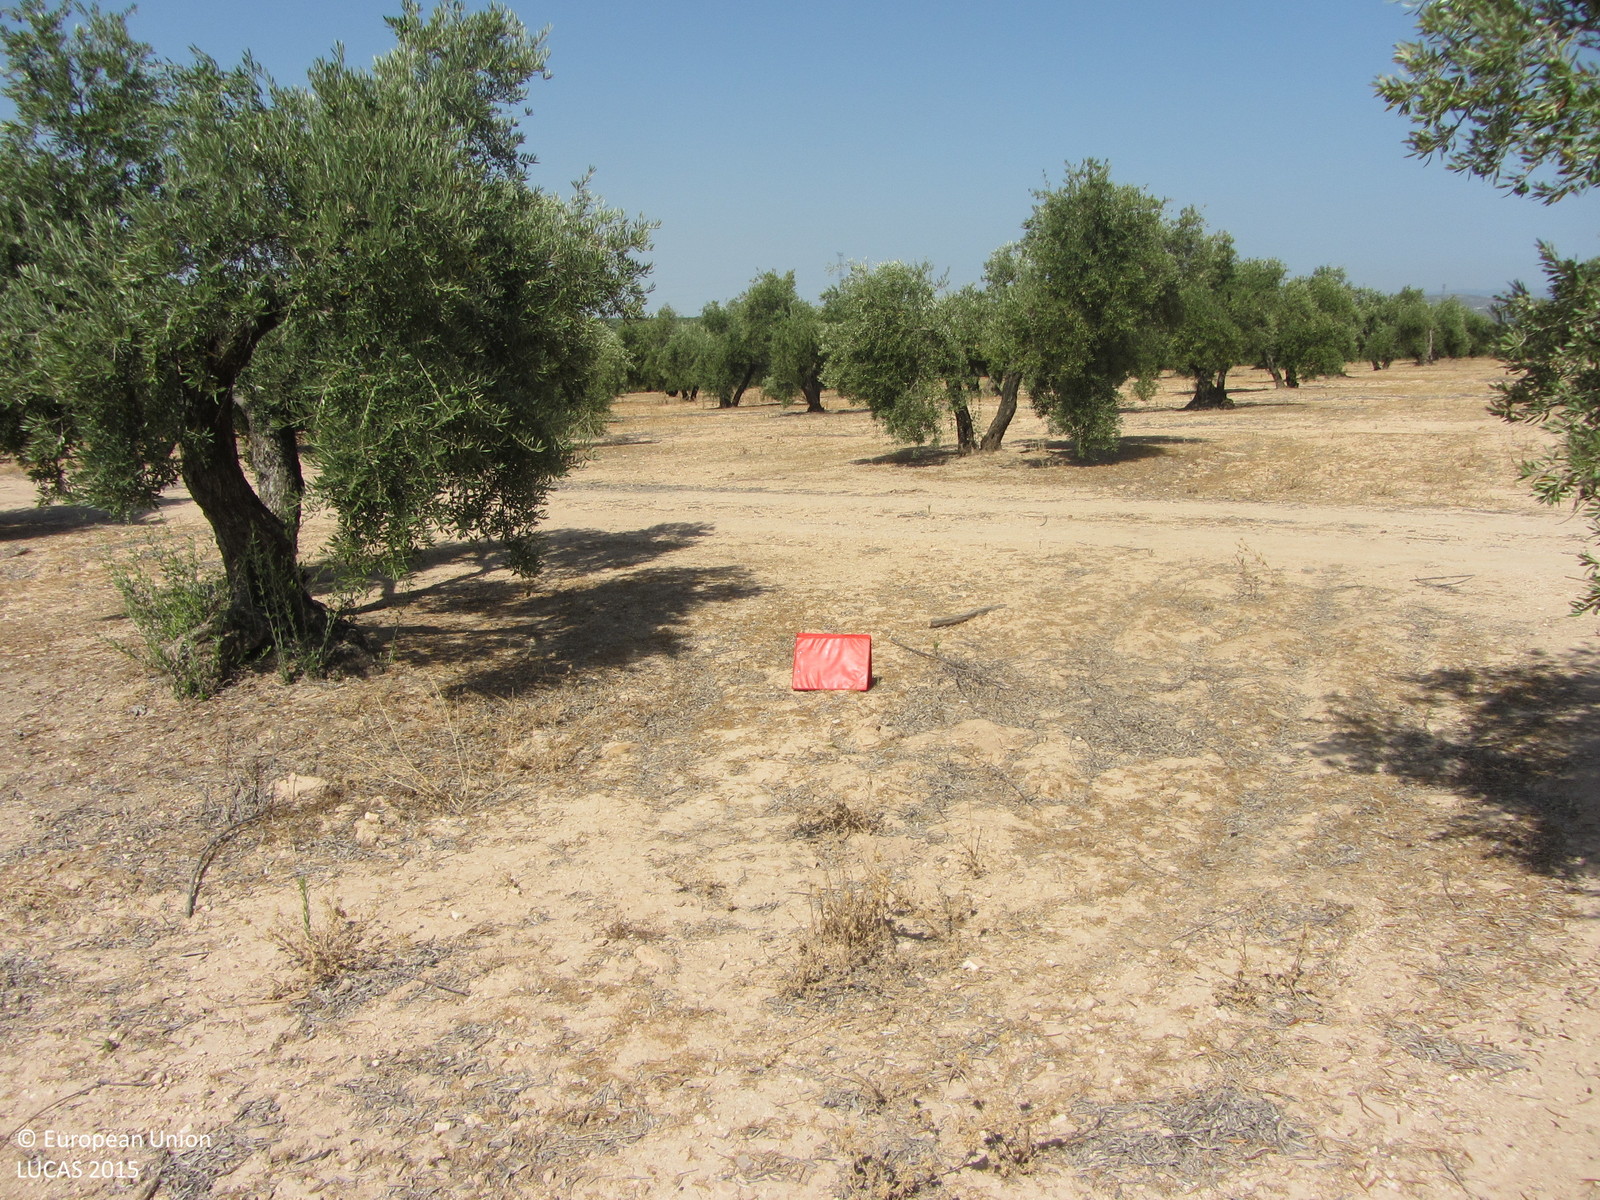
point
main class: Cropland
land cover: Olive groves
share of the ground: 25 - 50 %
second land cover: Other bare soil
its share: > 75 %
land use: Agriculture (excluding fallow land and kitchen gardens)
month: July
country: ES
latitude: 37.9976
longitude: -4.2093
